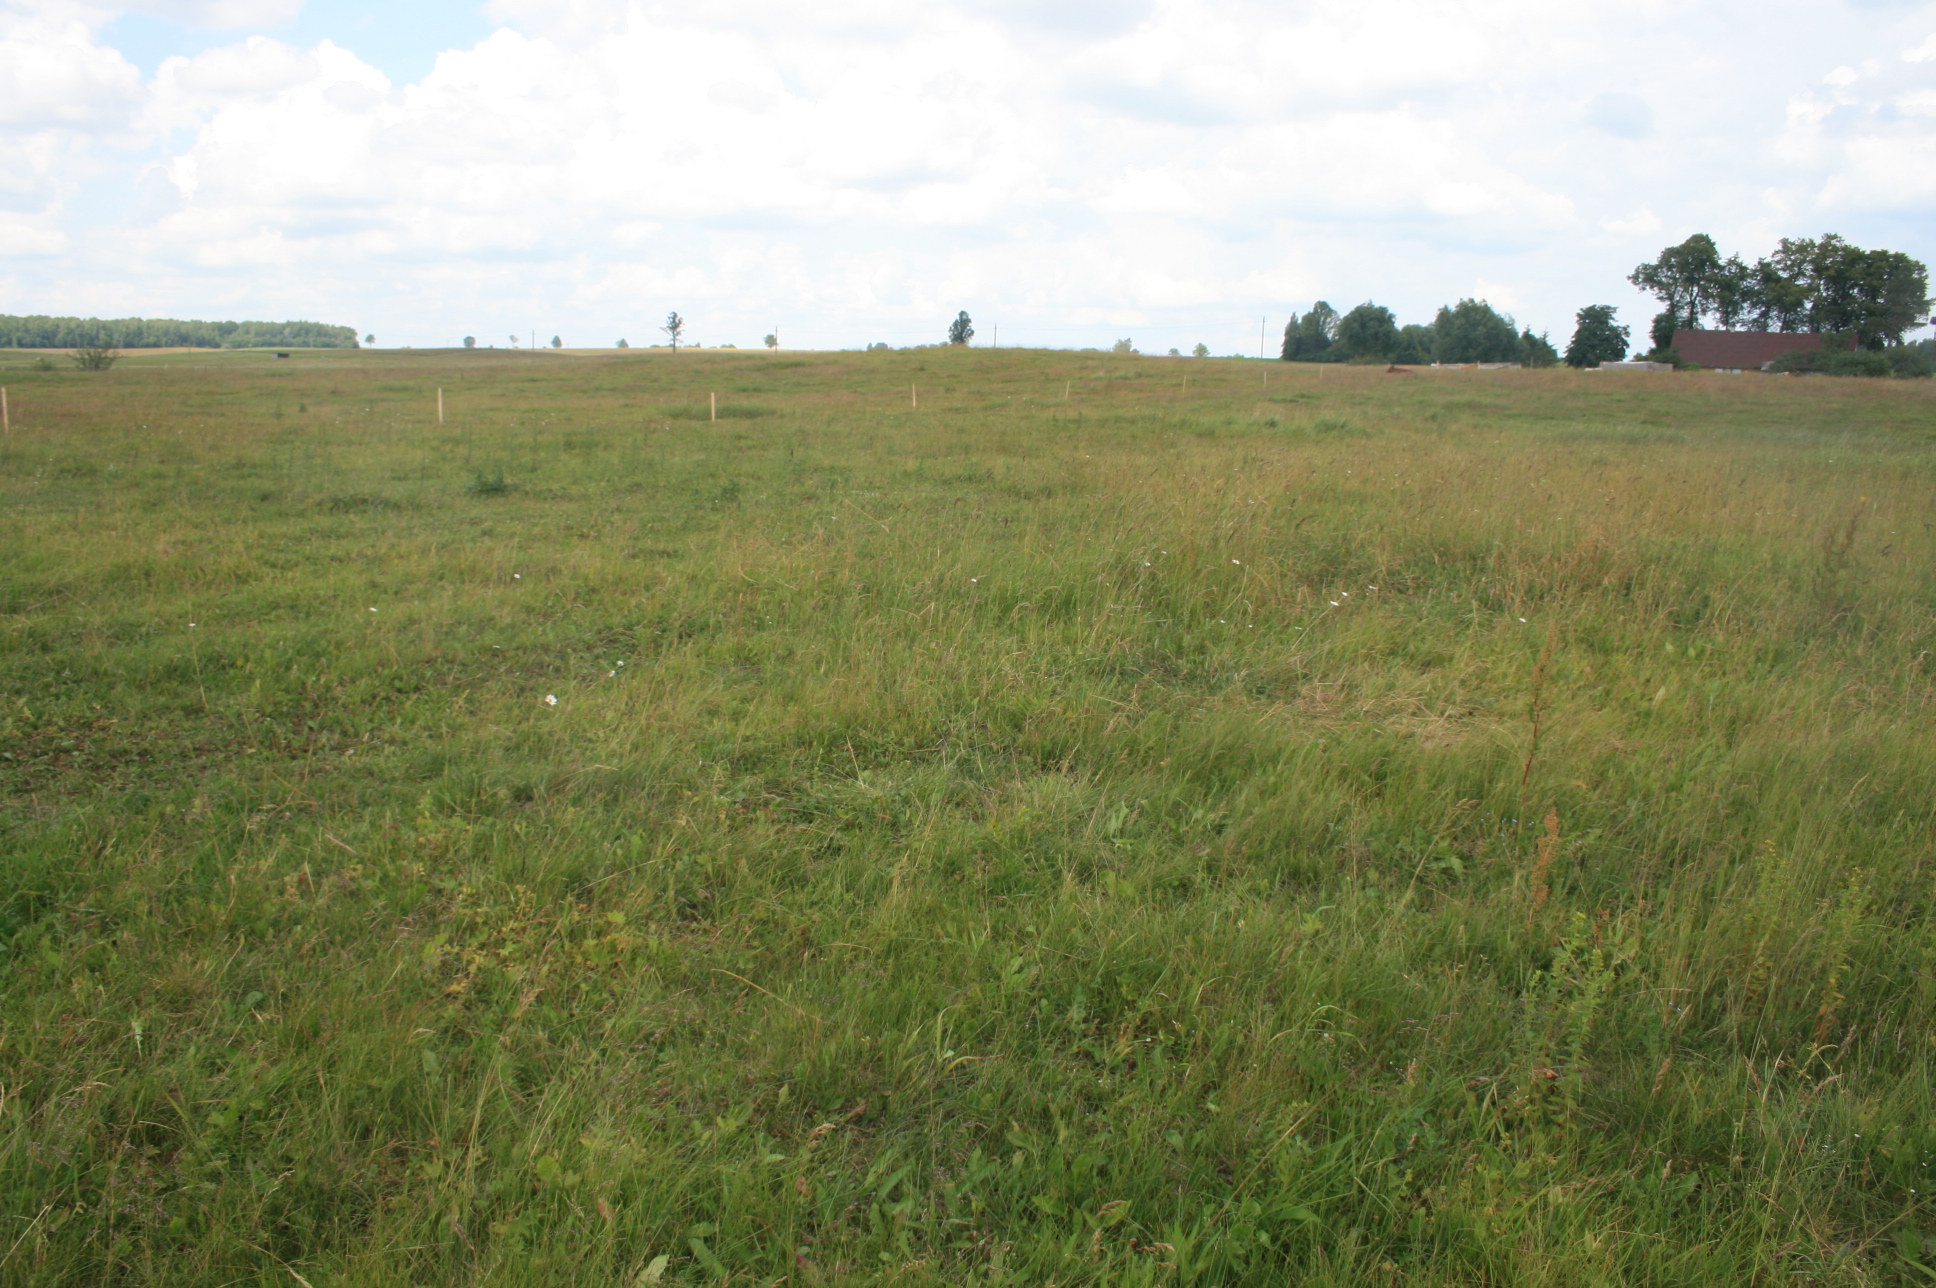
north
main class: Grassland
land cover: Grassland without tree/shrub cover
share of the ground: > 75 %
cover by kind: herbaceous plants 100 %
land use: Agriculture (excluding fallow land and kitchen gardens)
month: June
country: LT
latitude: 55.2586
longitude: 21.9962
